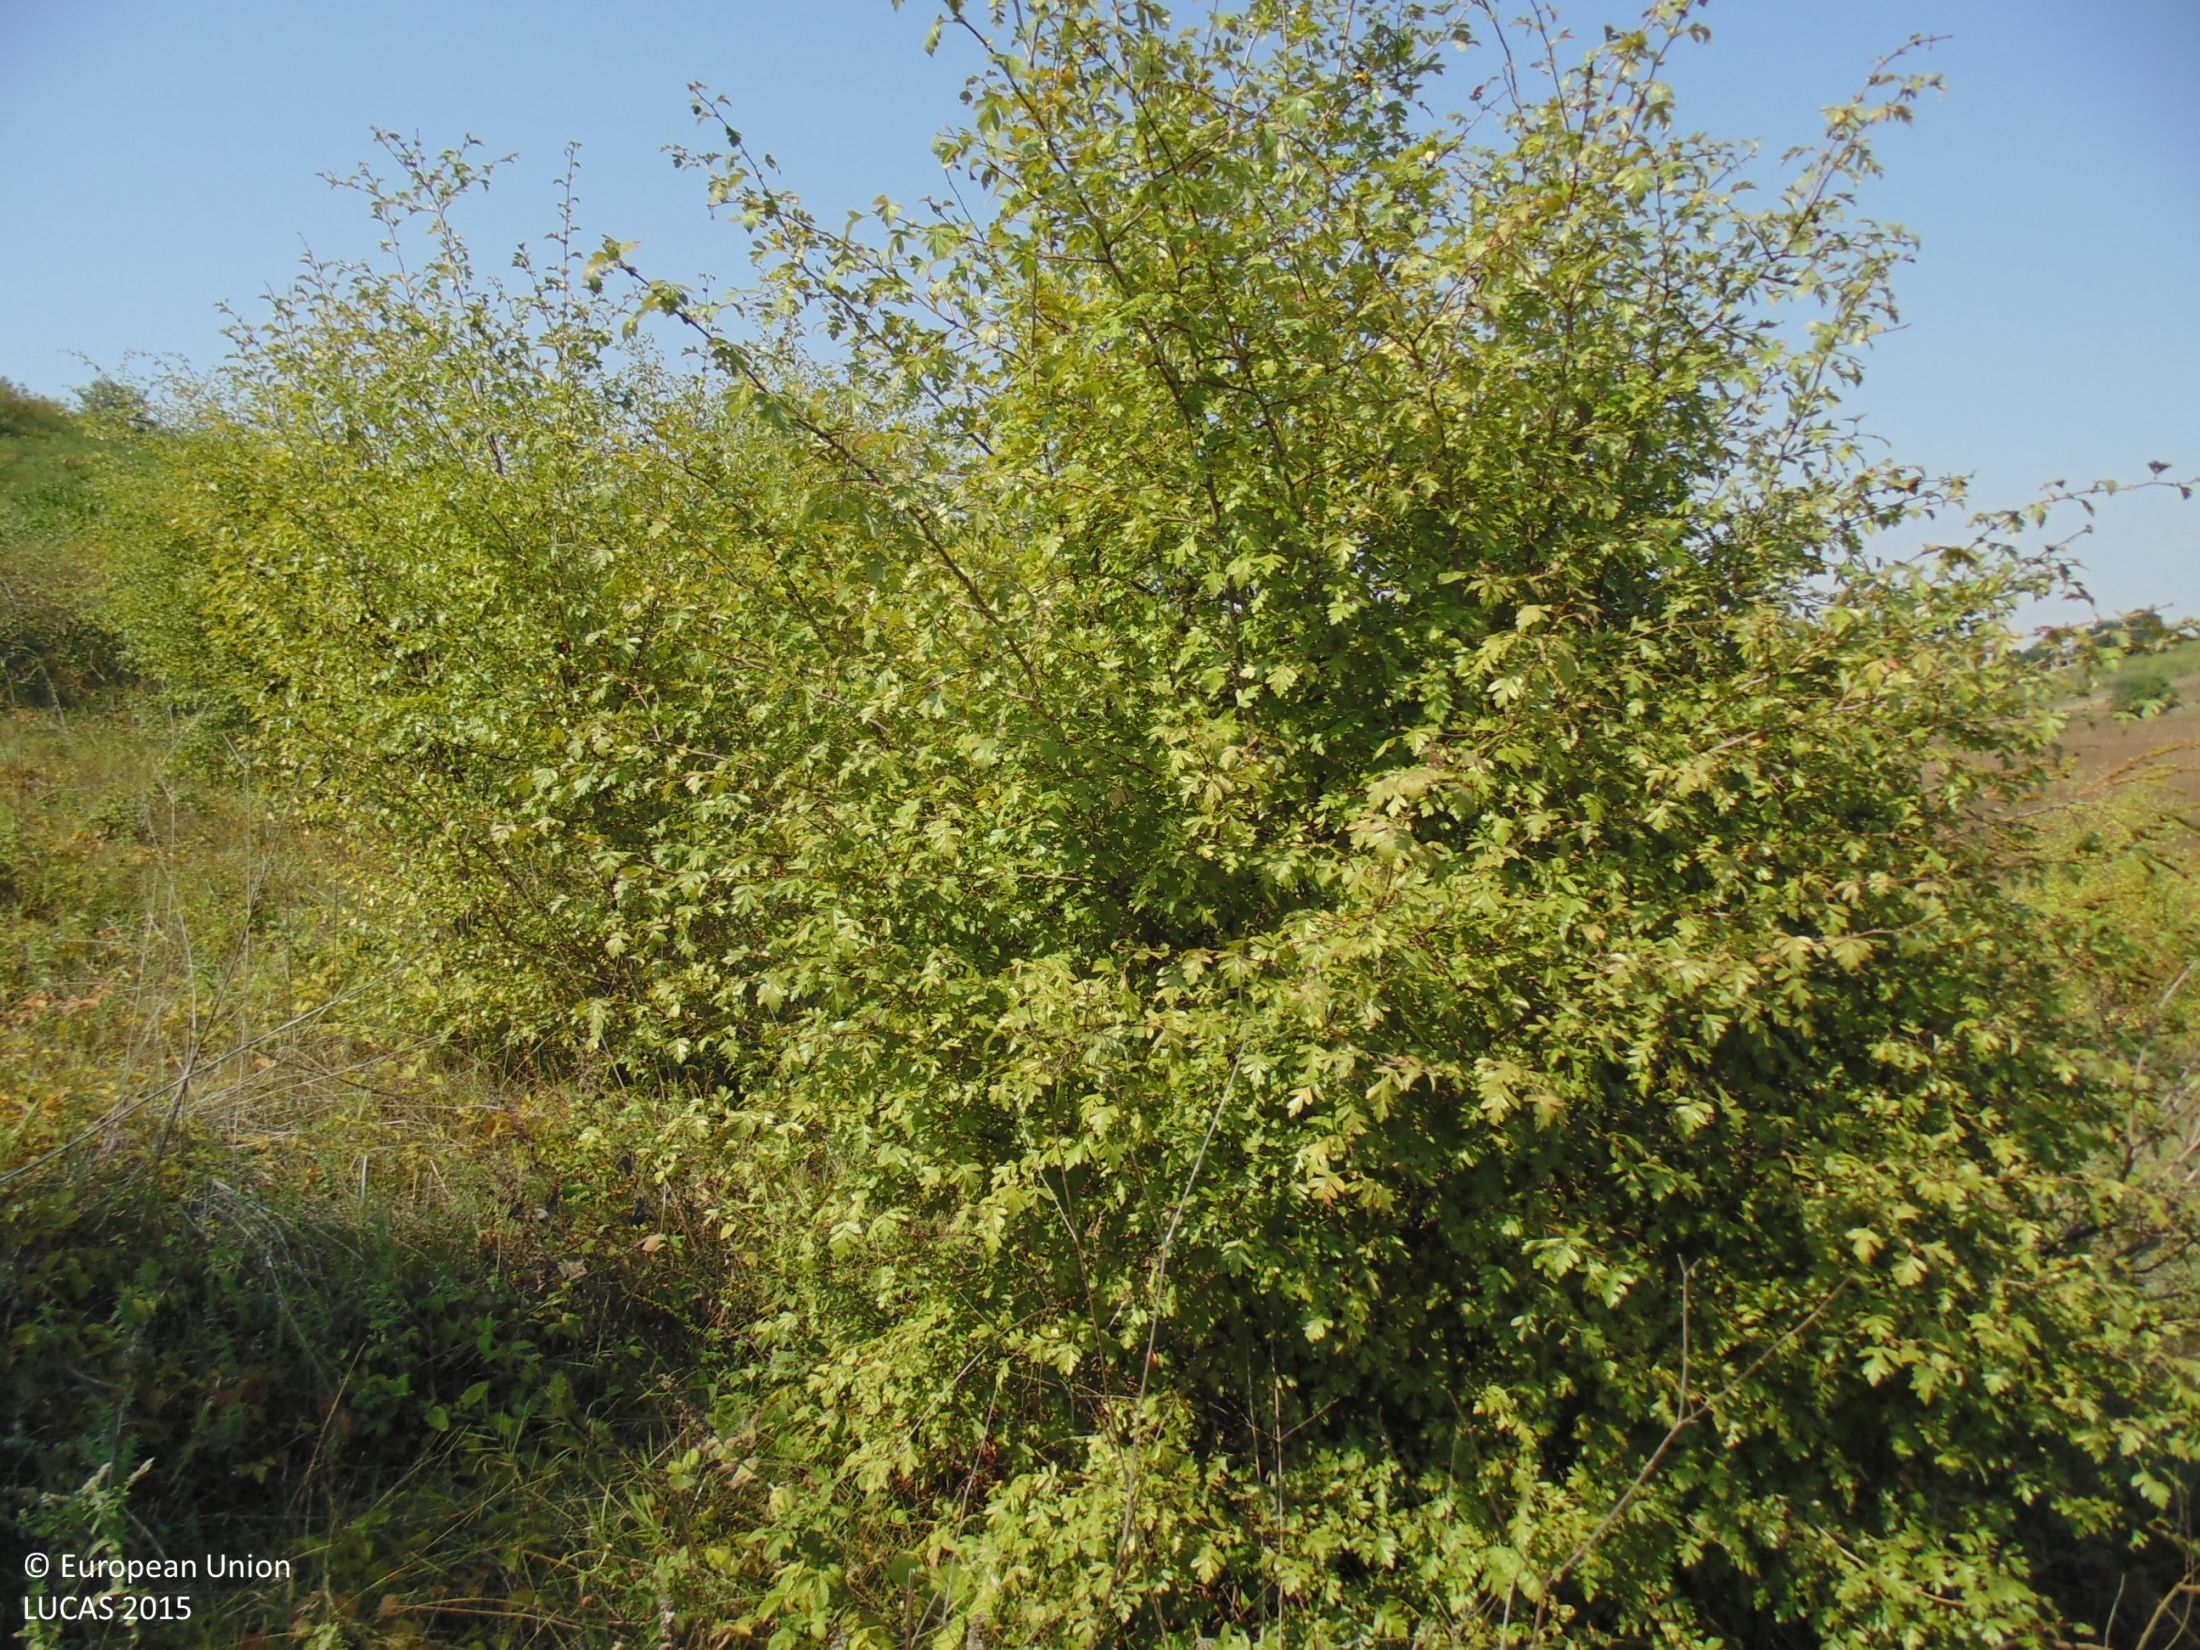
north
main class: Grassland
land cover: Grassland with sparse tree/shrub cover
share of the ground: > 75 %
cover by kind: herbaceous plants 90 %, broadleaved forest trees 5 %, shrubs 5 %
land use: Abandoned areas
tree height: < 5 m
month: August
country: BG
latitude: 43.9588
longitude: 27.3682
